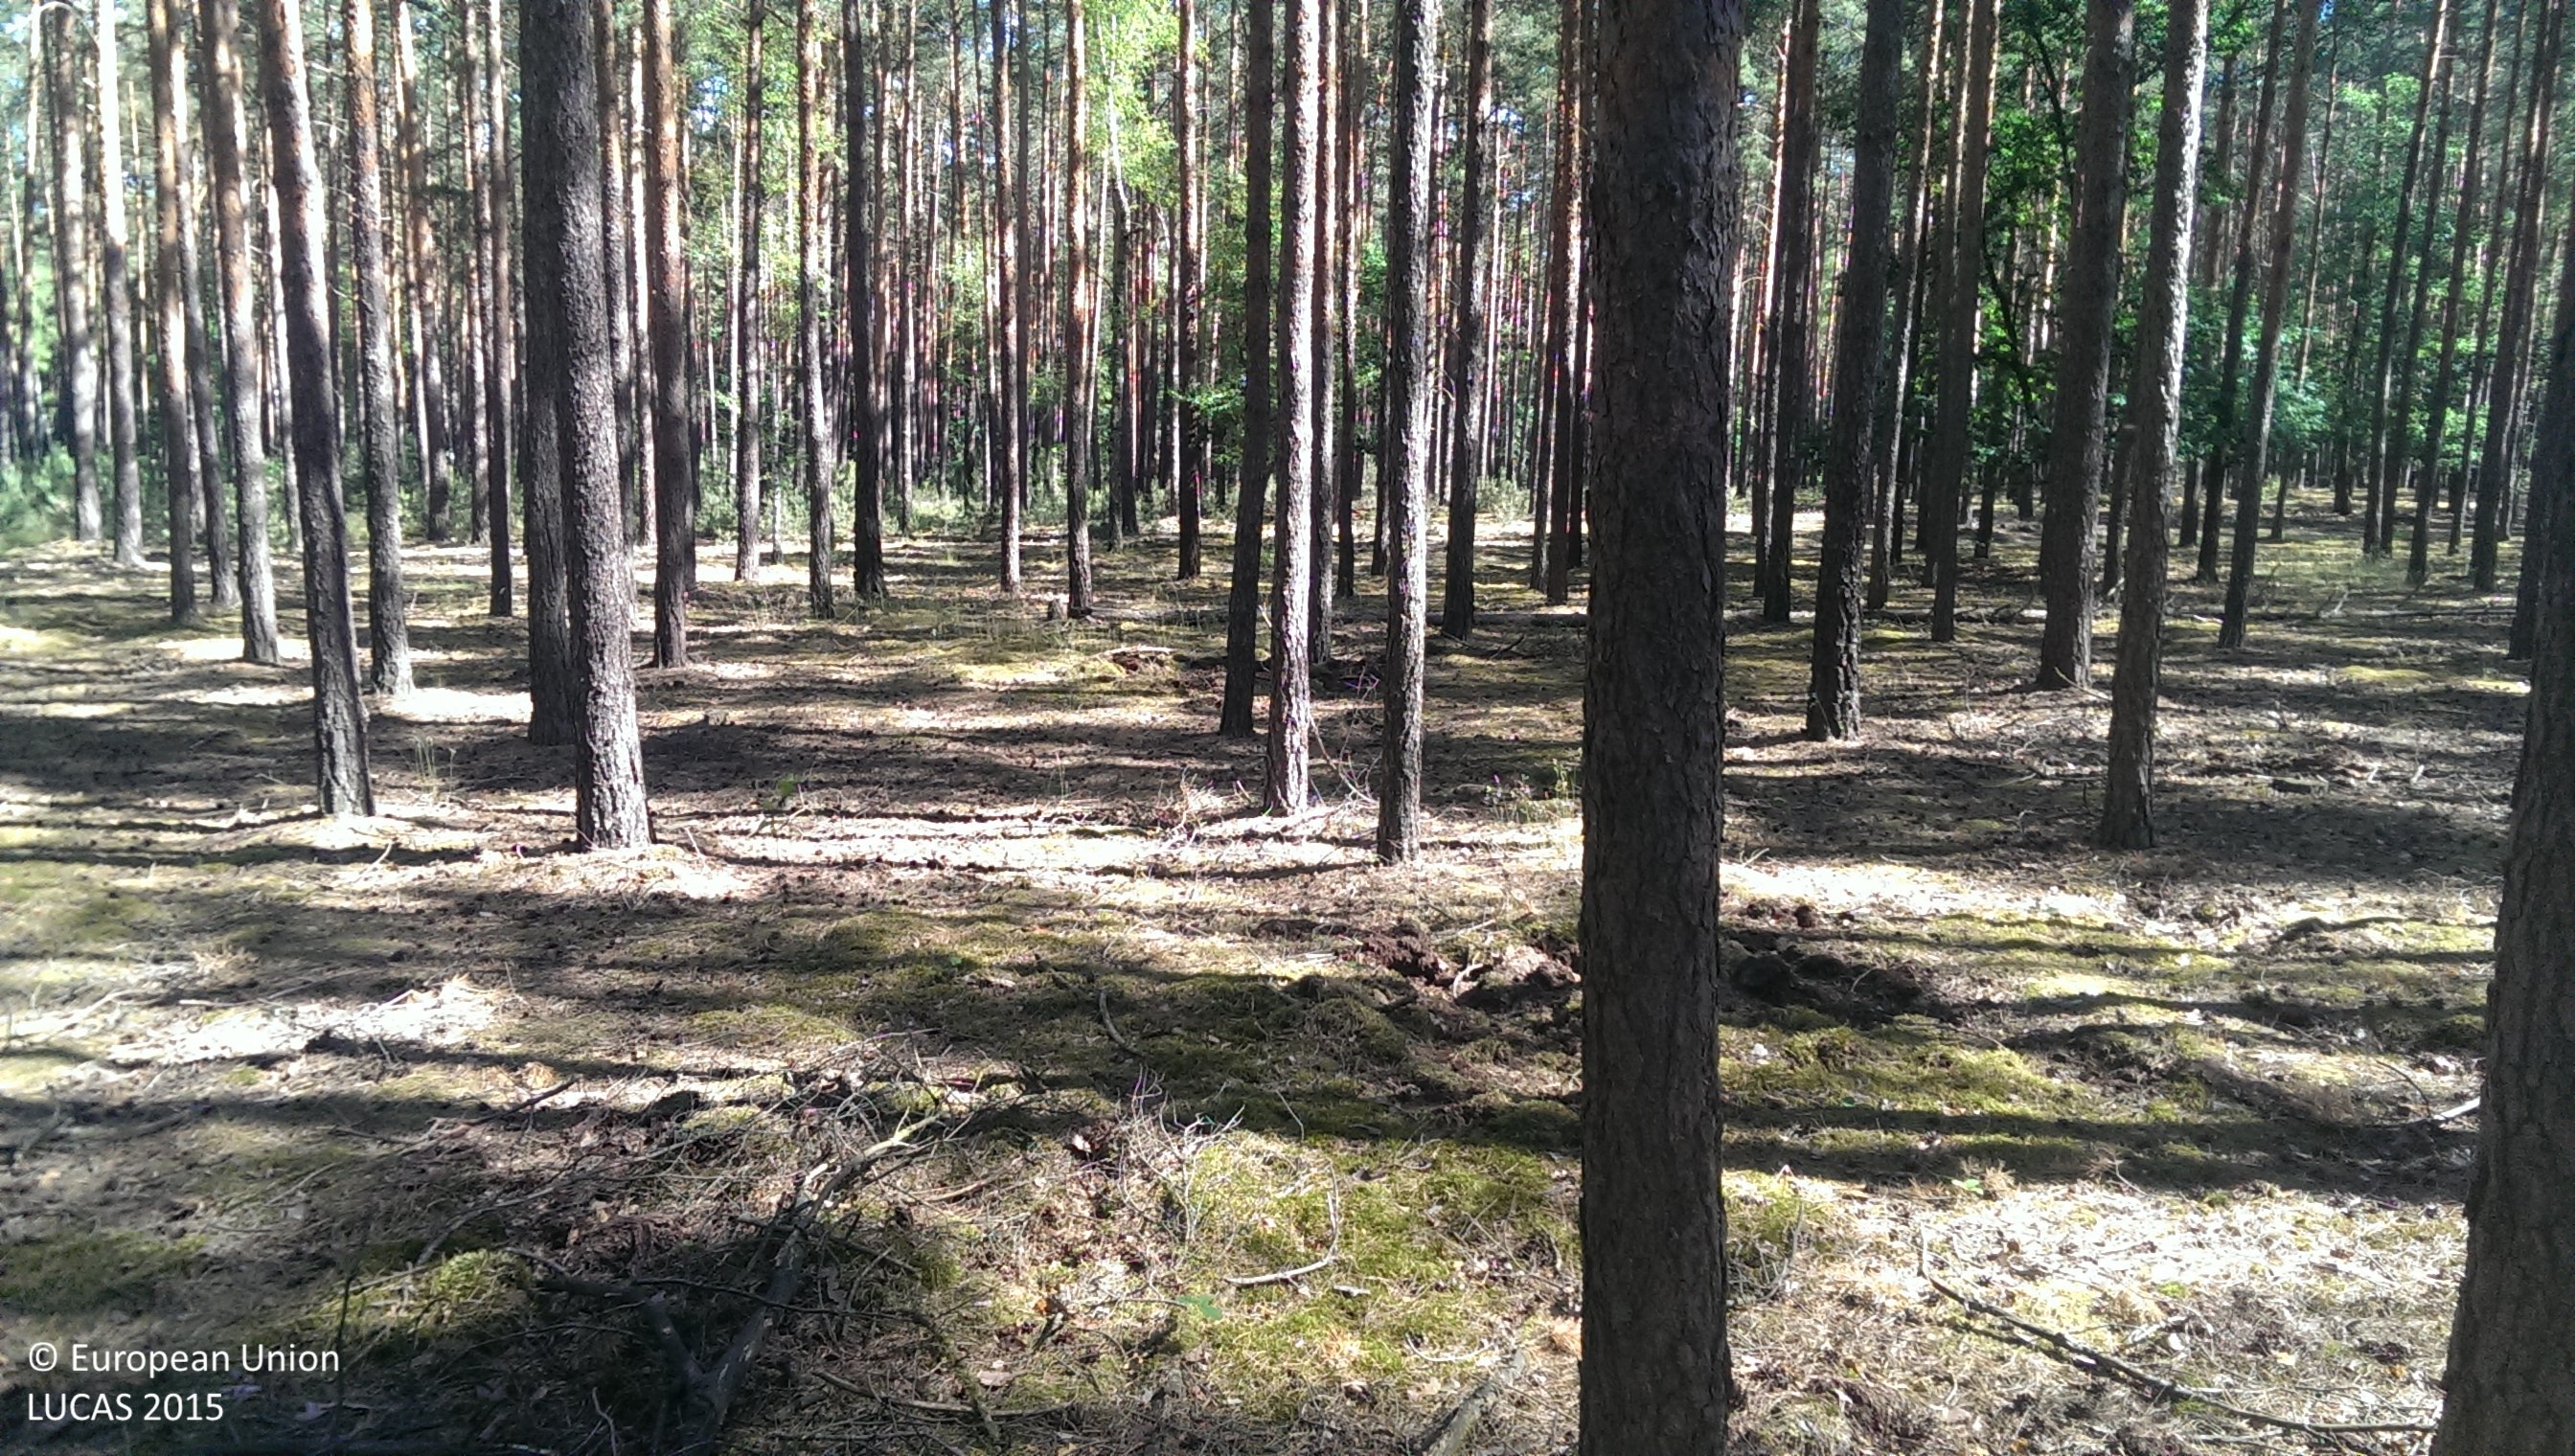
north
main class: Woodland
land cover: Pine dominated coniferous woodland
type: hemiboreal forest and nemoral coniferous forest and mixed broadleaved-coniferous forest
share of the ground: 50 - 75 %
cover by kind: coniferous forest trees 65 %, lichens and mosses 15 %, unconsolidated bare surface 15 %, broadleaved forest trees 5 %
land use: Forestry
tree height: > 5 m
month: June
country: PL
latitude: 51.9977
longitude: 16.2259
